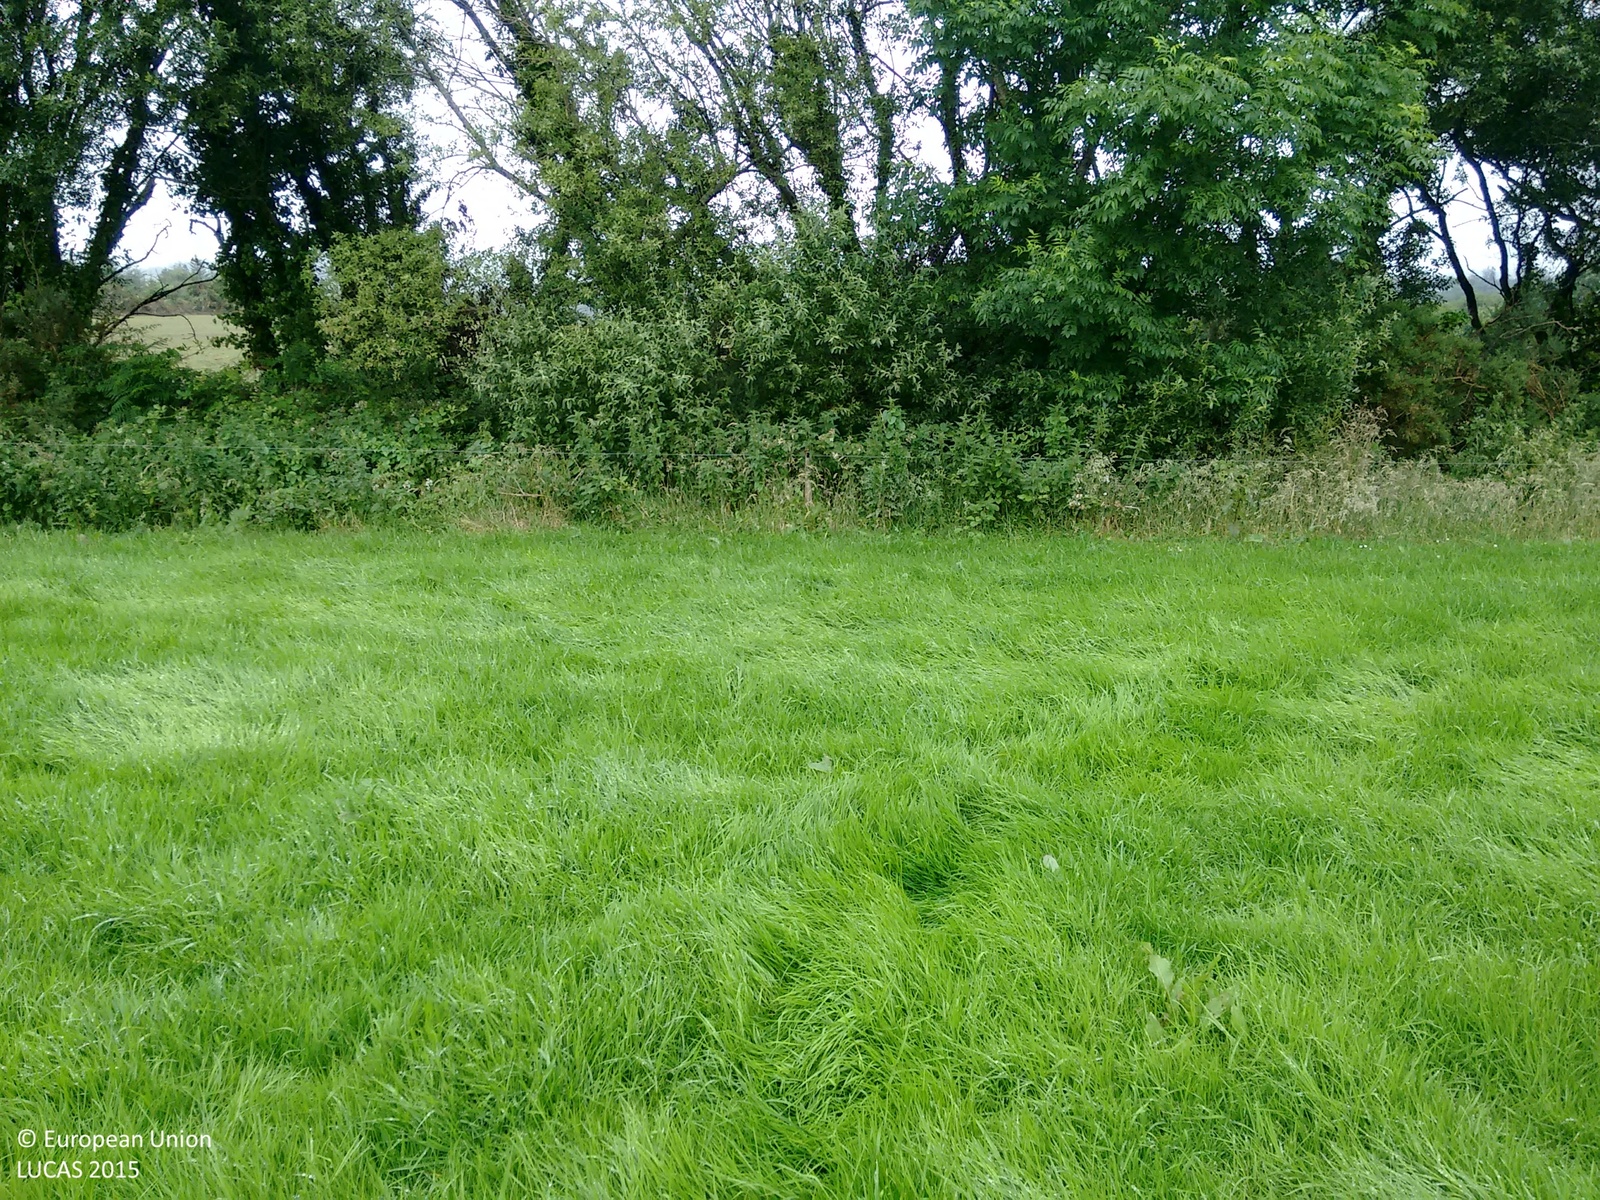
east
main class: Grassland
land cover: Grassland without tree/shrub cover
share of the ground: > 75 %
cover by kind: herbaceous plants 95 %, shrubs 5 %
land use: Agriculture (excluding fallow land and kitchen gardens)
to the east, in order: Grassland without tree/shrub cover; Fences; Ditches and canals; Abandoned hedges; Grassland without tree/shrub cover; Broadleaved woodland; Grassland without tree/shrub cover
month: July
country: IE
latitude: 51.7282
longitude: -9.1111
